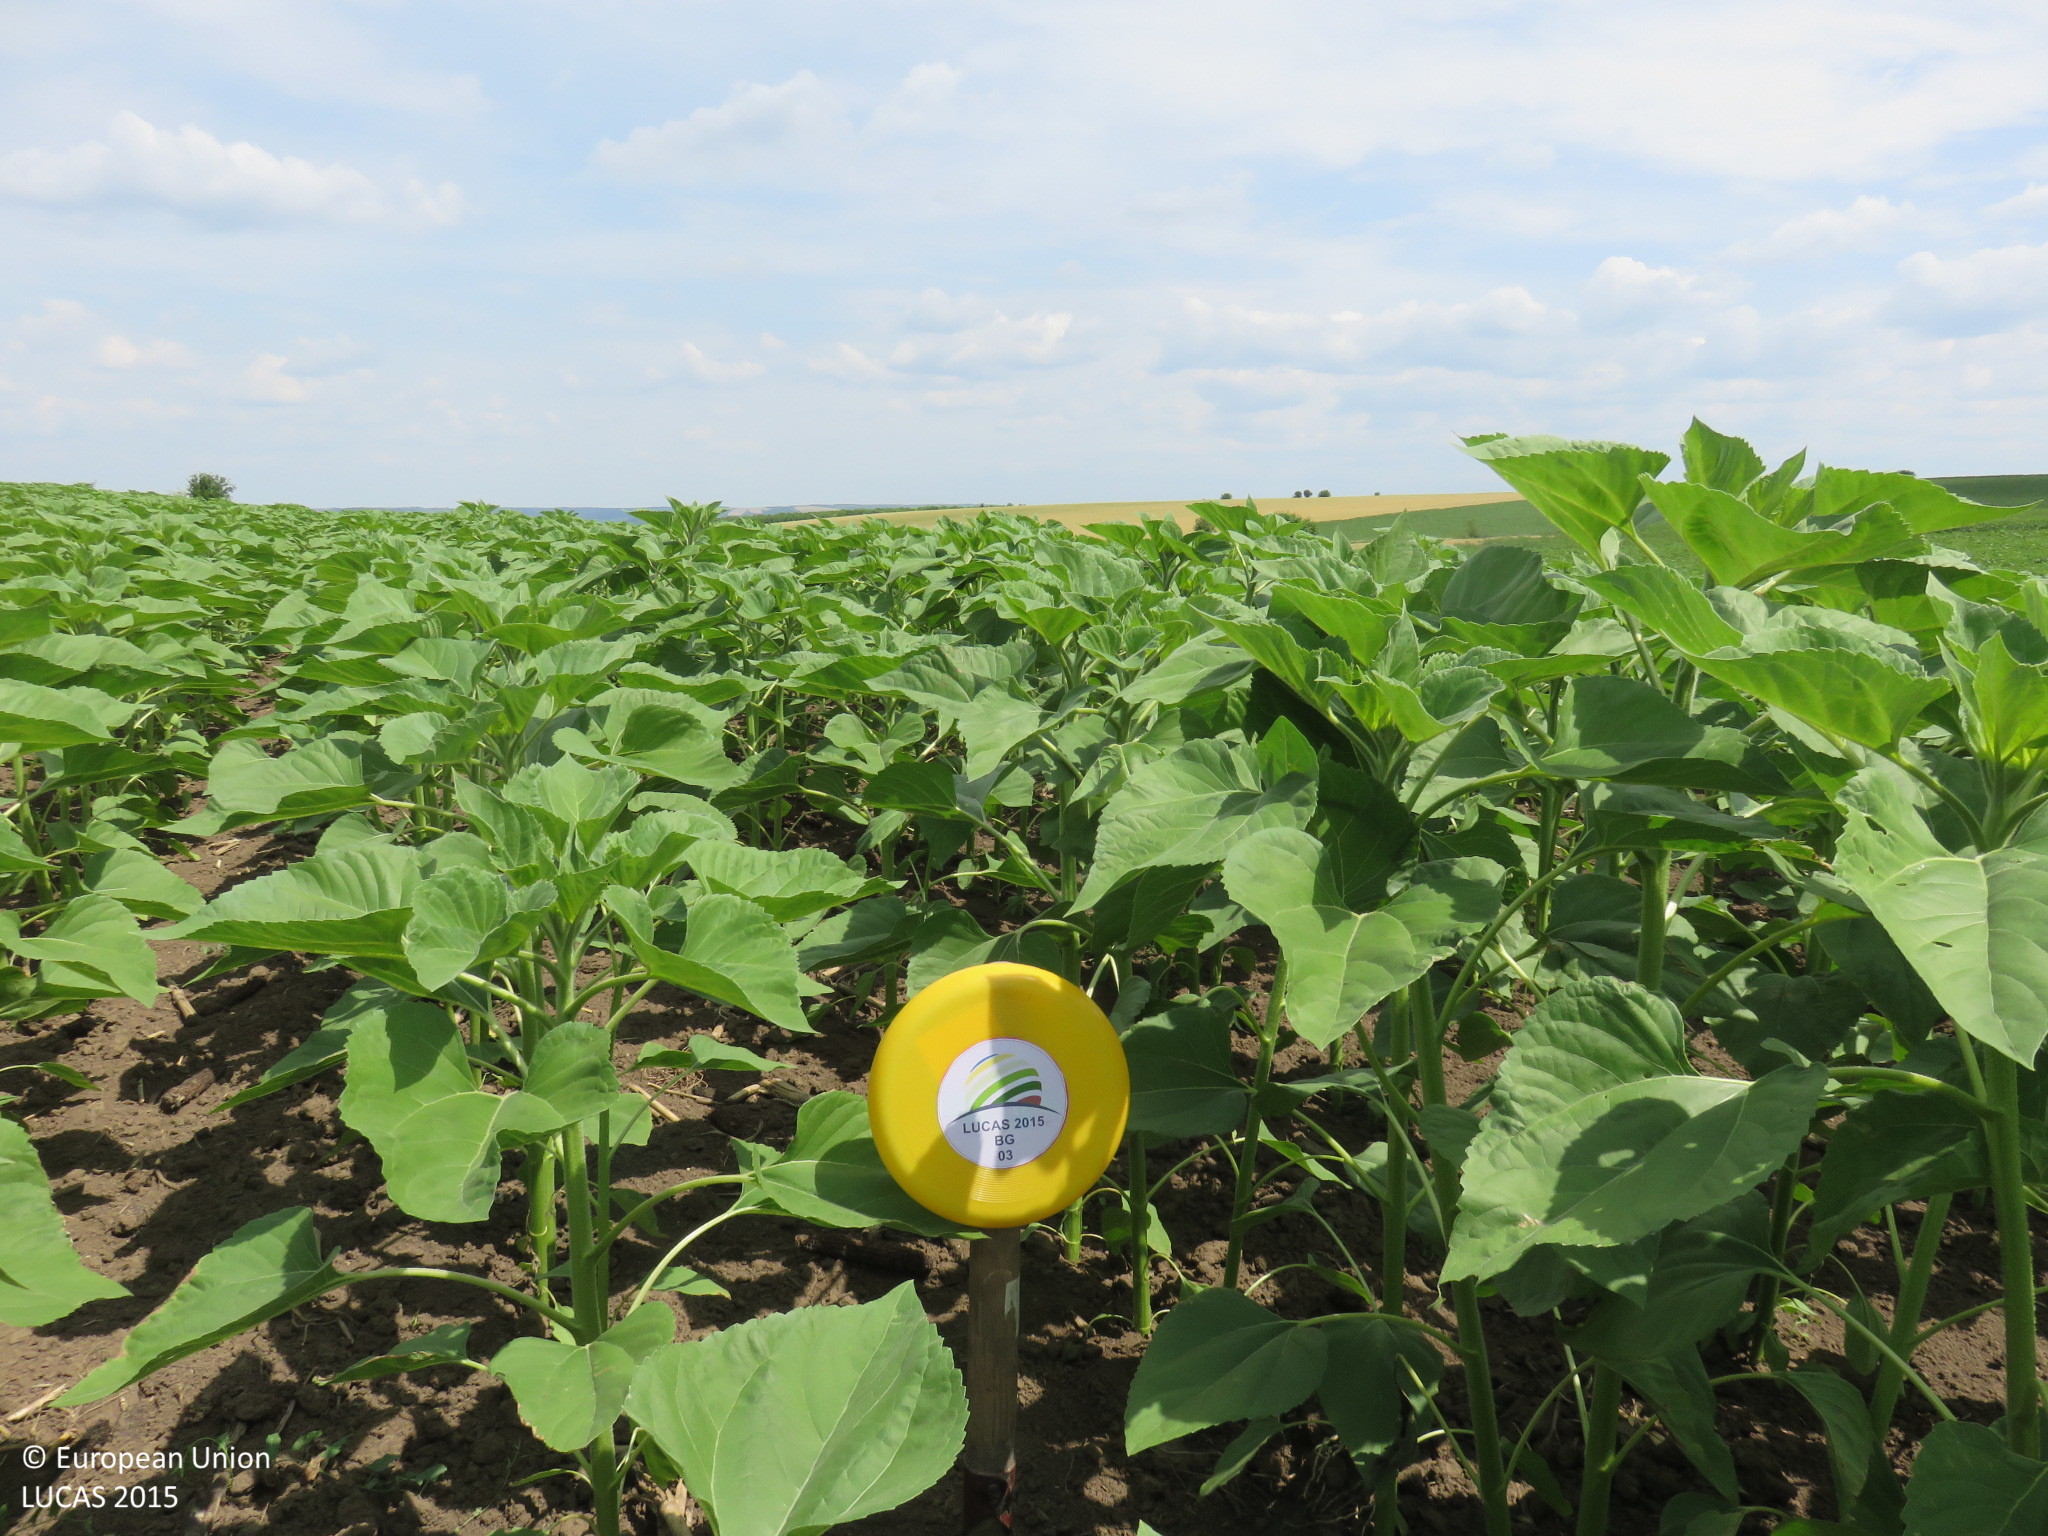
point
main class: Cropland
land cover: Sunflower
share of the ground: > 75 %
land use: Agriculture (excluding fallow land and kitchen gardens)
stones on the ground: < 10 %
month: June
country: BG
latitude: 43.4951
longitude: 24.4679
